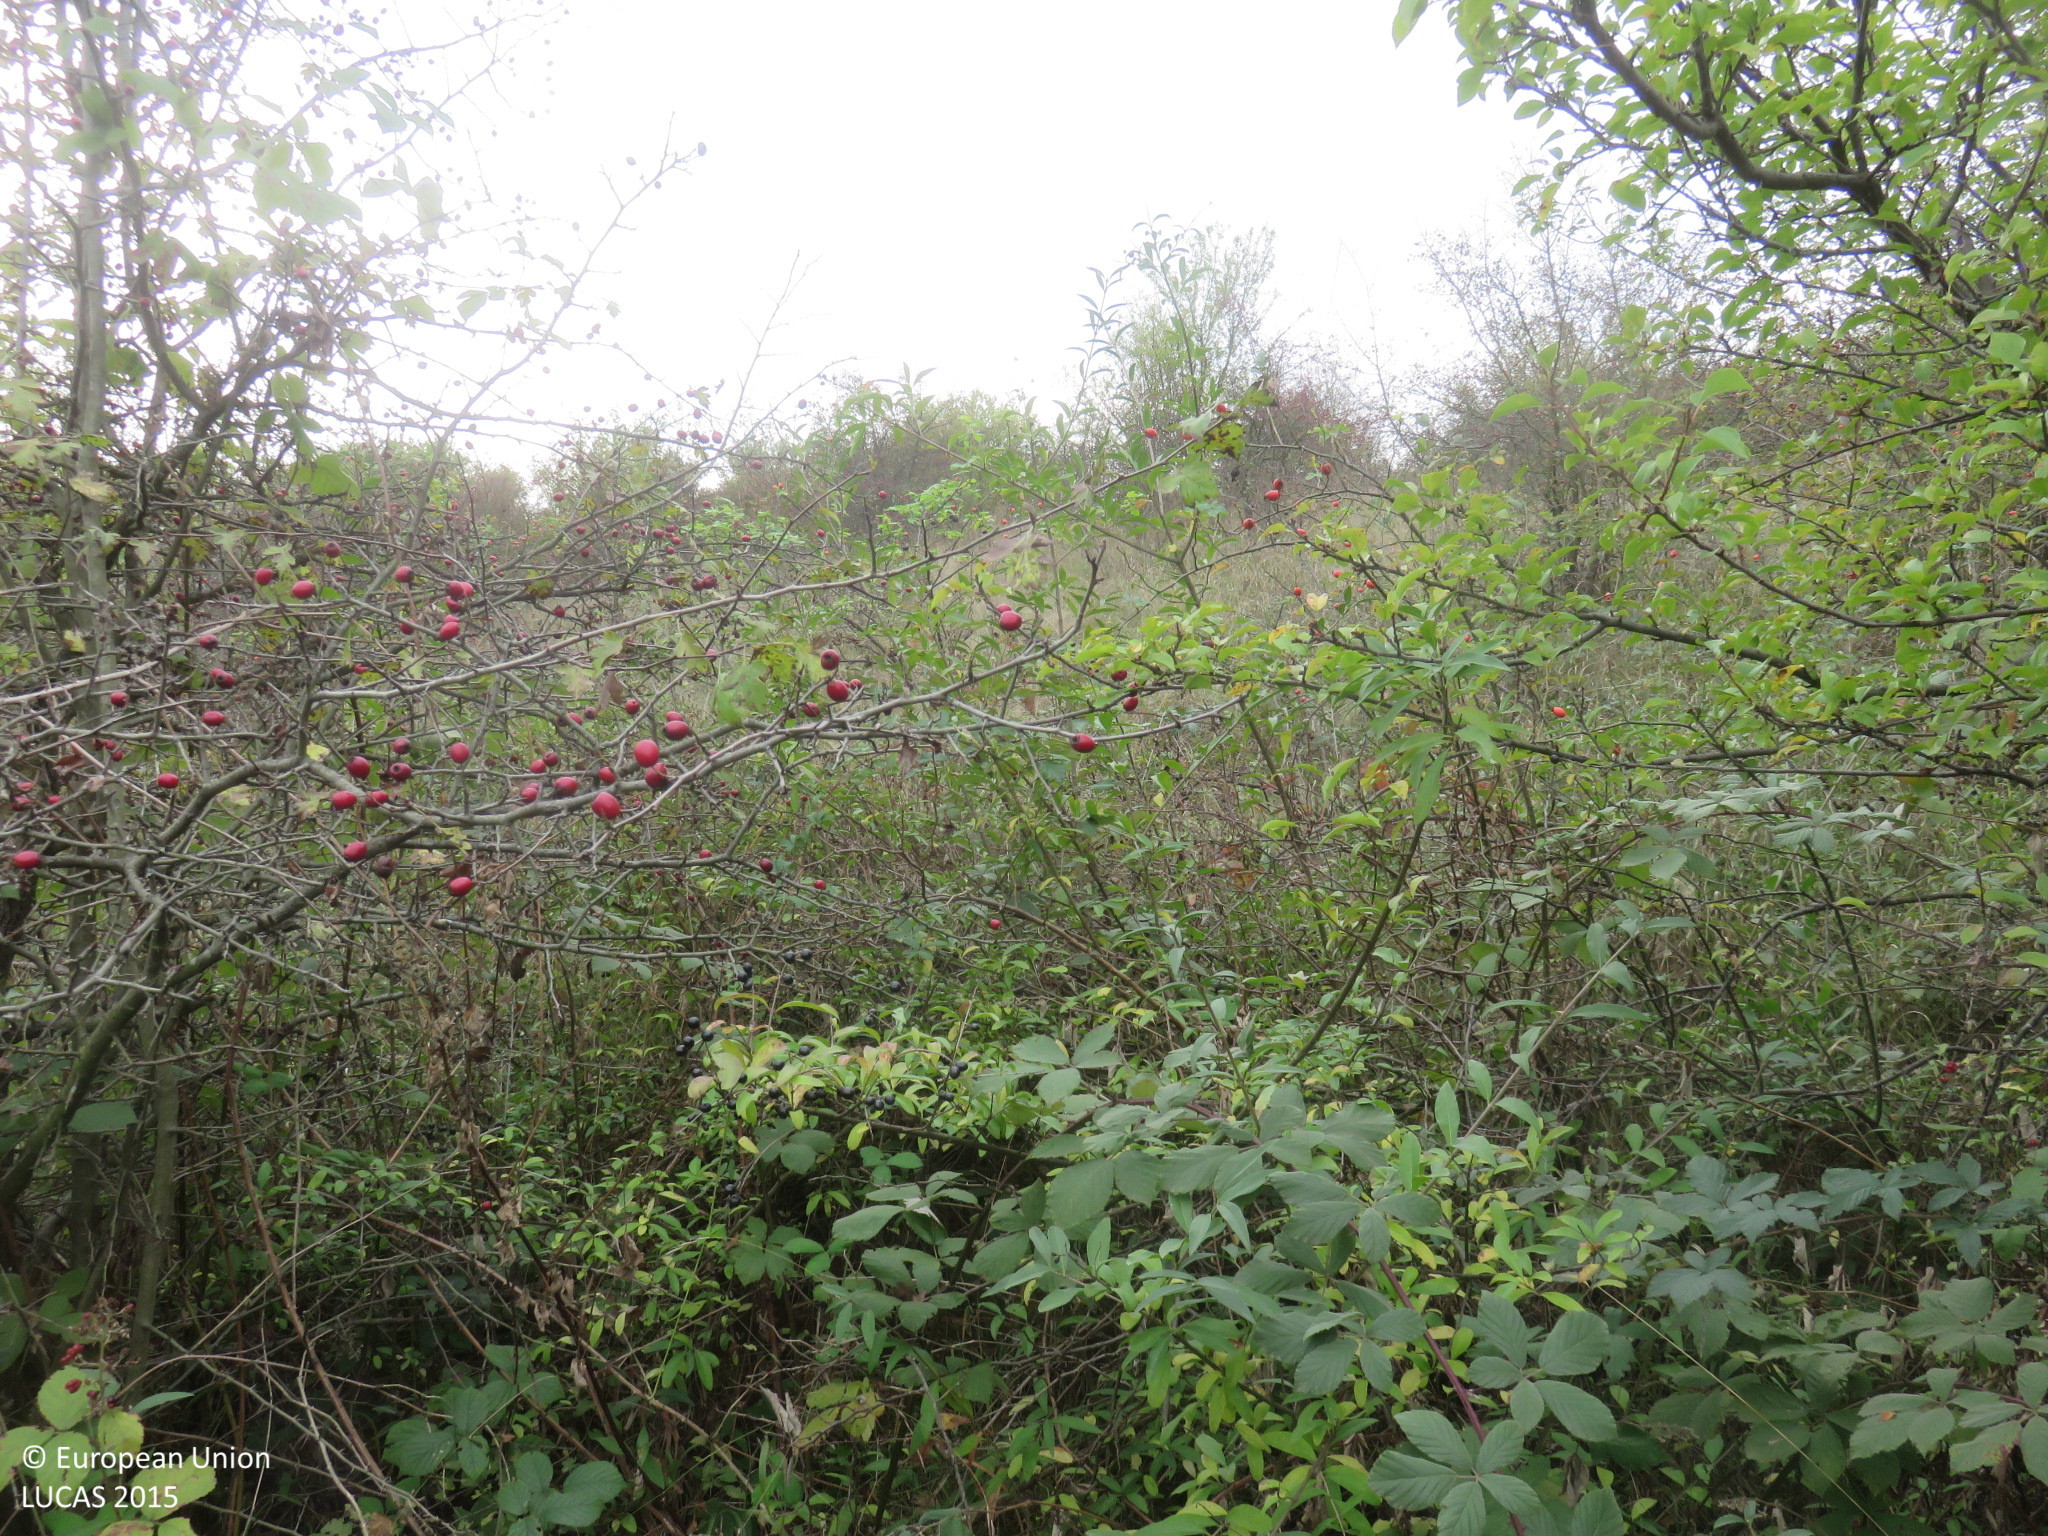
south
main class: Shrubland
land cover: Shrubland with sparse tree cover
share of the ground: > 75 %
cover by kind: shrubs 90 %, broadleaved forest trees 5 %, herbaceous plants 5 %
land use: Semi-natural and natural areas not in use
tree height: < 5 m
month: October
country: BG
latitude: 42.9331
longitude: 25.1771
